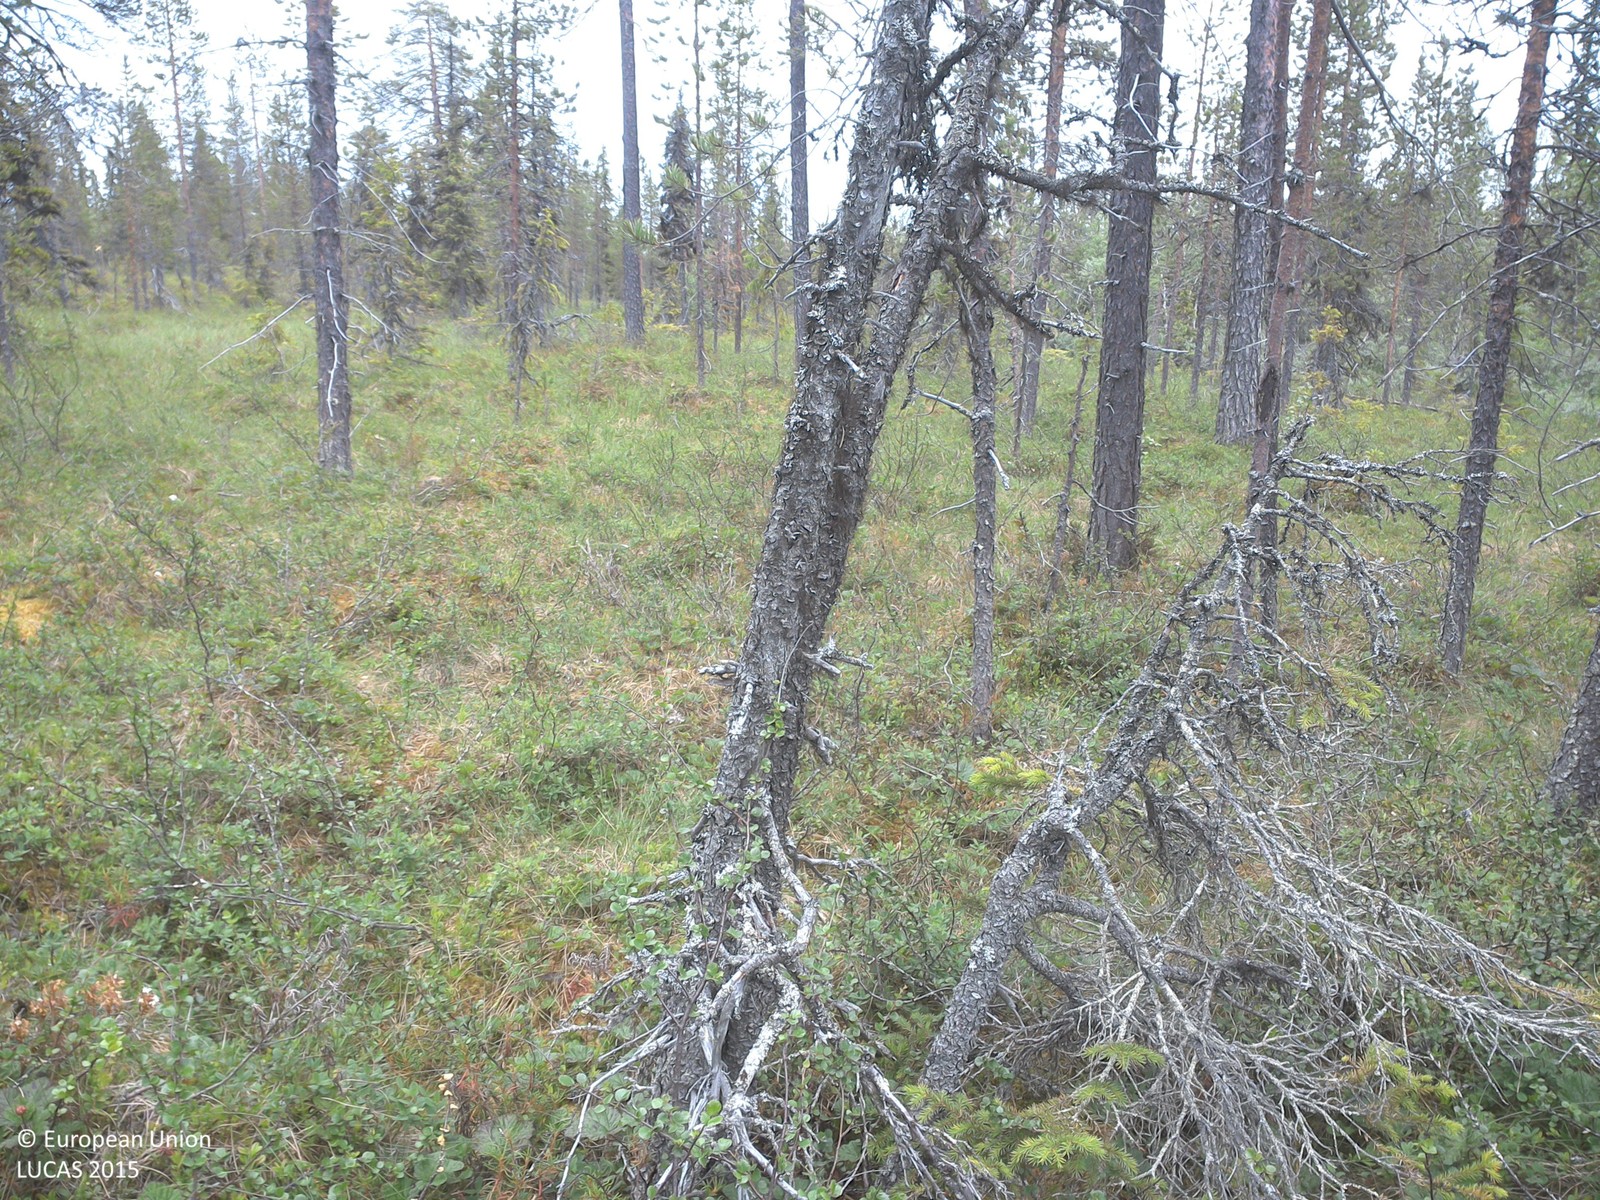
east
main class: Woodland
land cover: Pine dominated coniferous woodland
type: boreal forest
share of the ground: 10 - 25 %
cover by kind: shrubs 40 %, lichens and mosses 30 %, coniferous forest trees 15 %, herbaceous plants 15 %
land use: Semi-natural and natural areas not in use
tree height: > 5 m
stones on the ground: < 10 %
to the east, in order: Pine dominated coniferous woodland; Spruce dominated mixed woodland; Pine dominated coniferous woodland; Spruce dominated coniferous woodland; Peatbogs
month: July
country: SE
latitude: 67.6180
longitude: 22.9274
